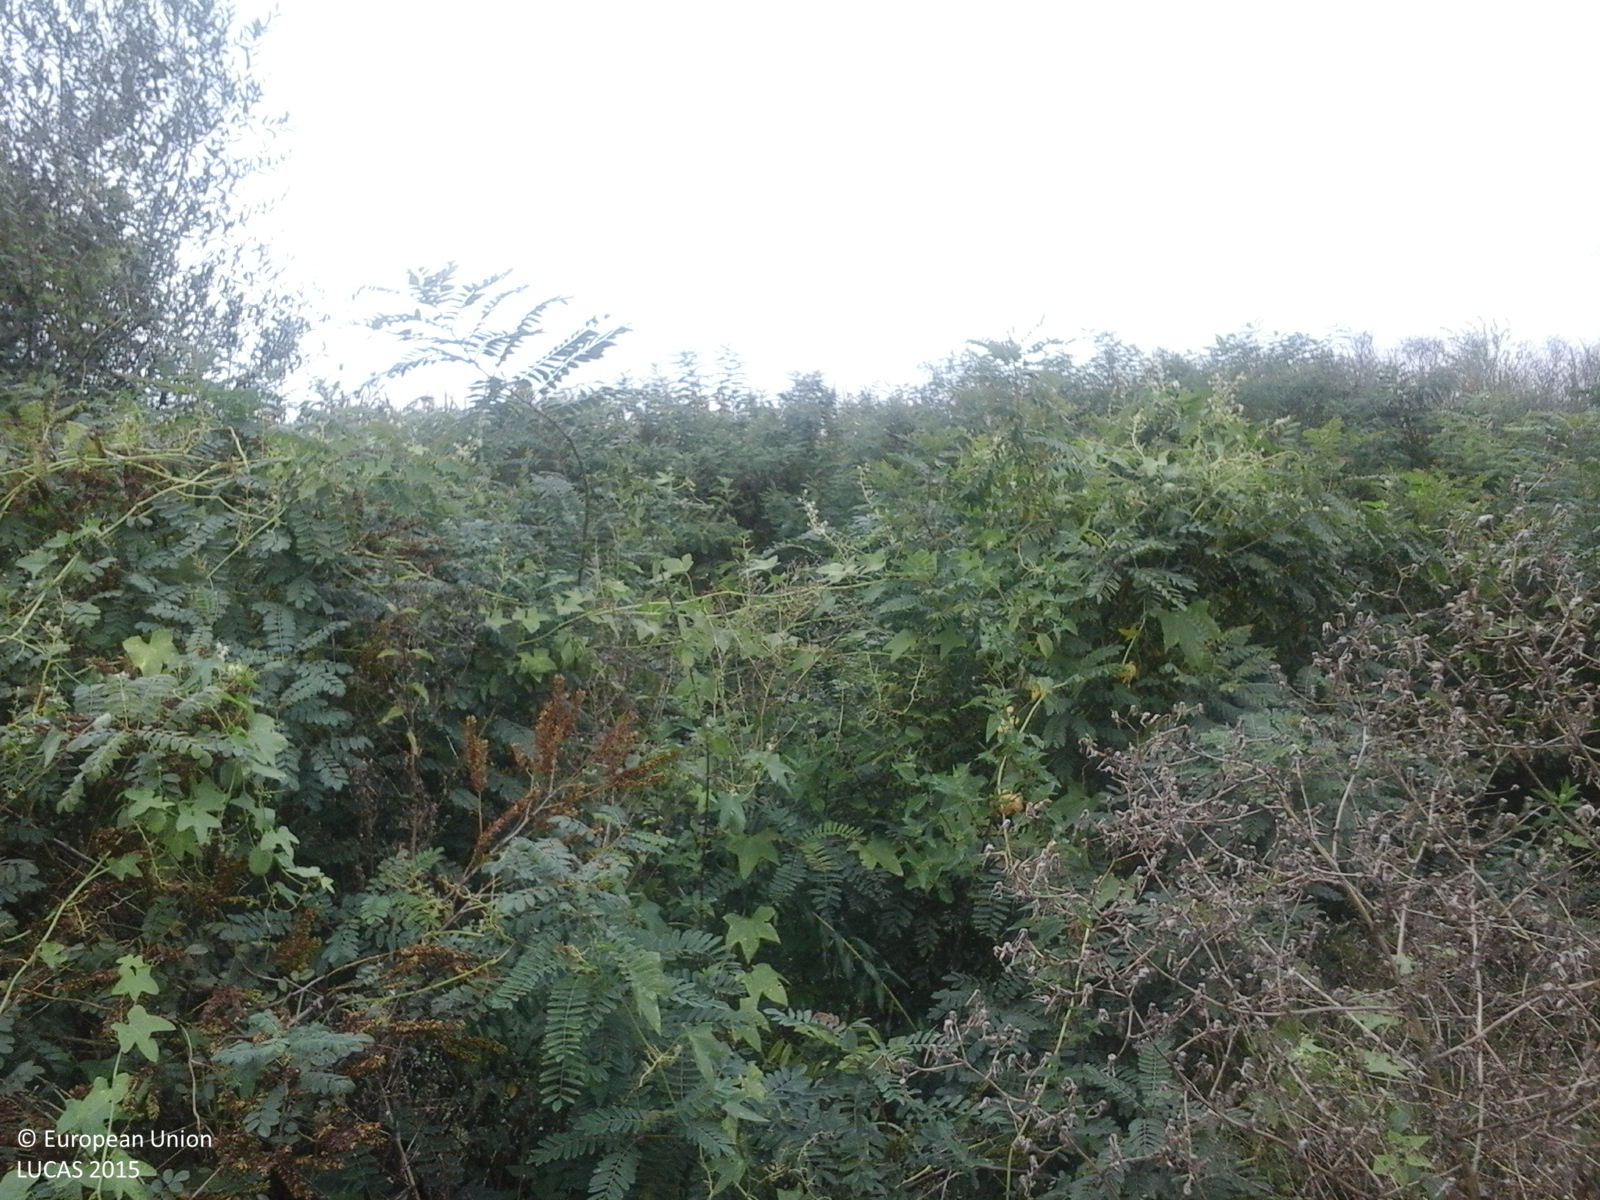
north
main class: Shrubland
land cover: Shrubland with sparse tree cover
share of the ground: > 75 %
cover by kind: shrubs 75 %, herbaceous plants 20 %, broadleaved forest trees 5 %
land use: Semi-natural and natural areas not in use
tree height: < 5 m
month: September
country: RO
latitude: 47.3233
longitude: 22.0499
